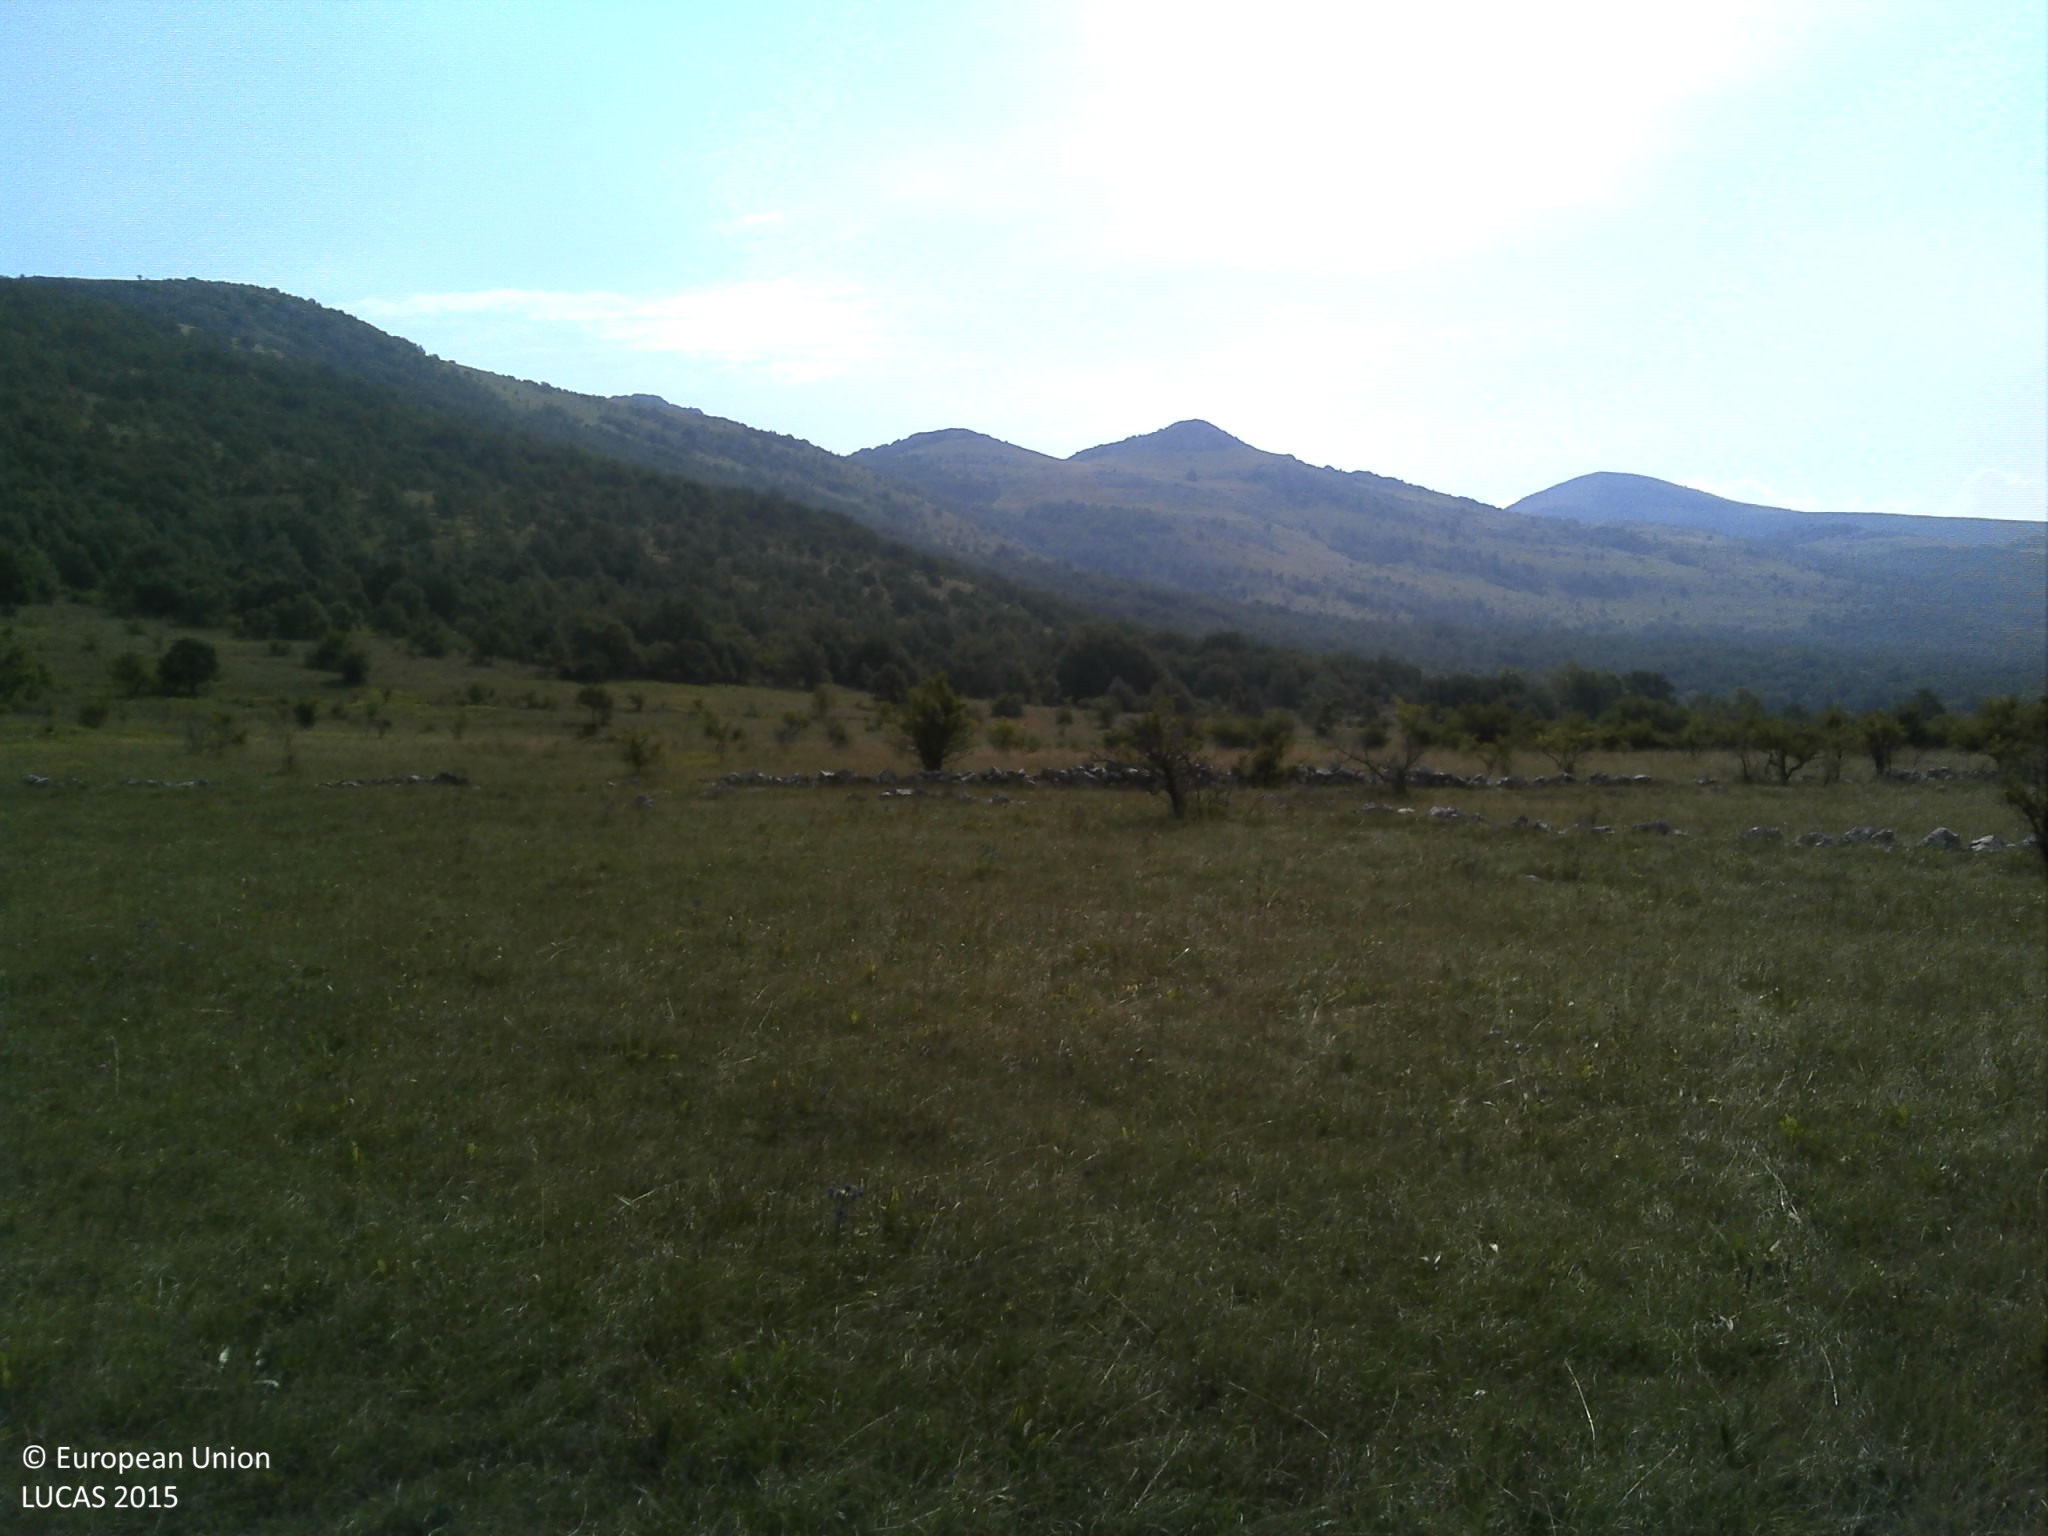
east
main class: Grassland
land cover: Grassland with sparse tree/shrub cover
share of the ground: > 75 %
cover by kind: herbaceous plants 85 %, shrubs 10 %, broadleaved forest trees 5 %
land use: Semi-natural and natural areas not in use
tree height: < 5 m
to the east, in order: Tracks; Grassland without tree/shrub cover; Tracks; Grassland without tree/shrub cover; Dry stone walls; Grassland without tree/shrub cover; Grassland with sparse tree/shrub cover; Grassland without tree/shrub cover
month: September
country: HR
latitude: 44.3604
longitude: 15.9532
